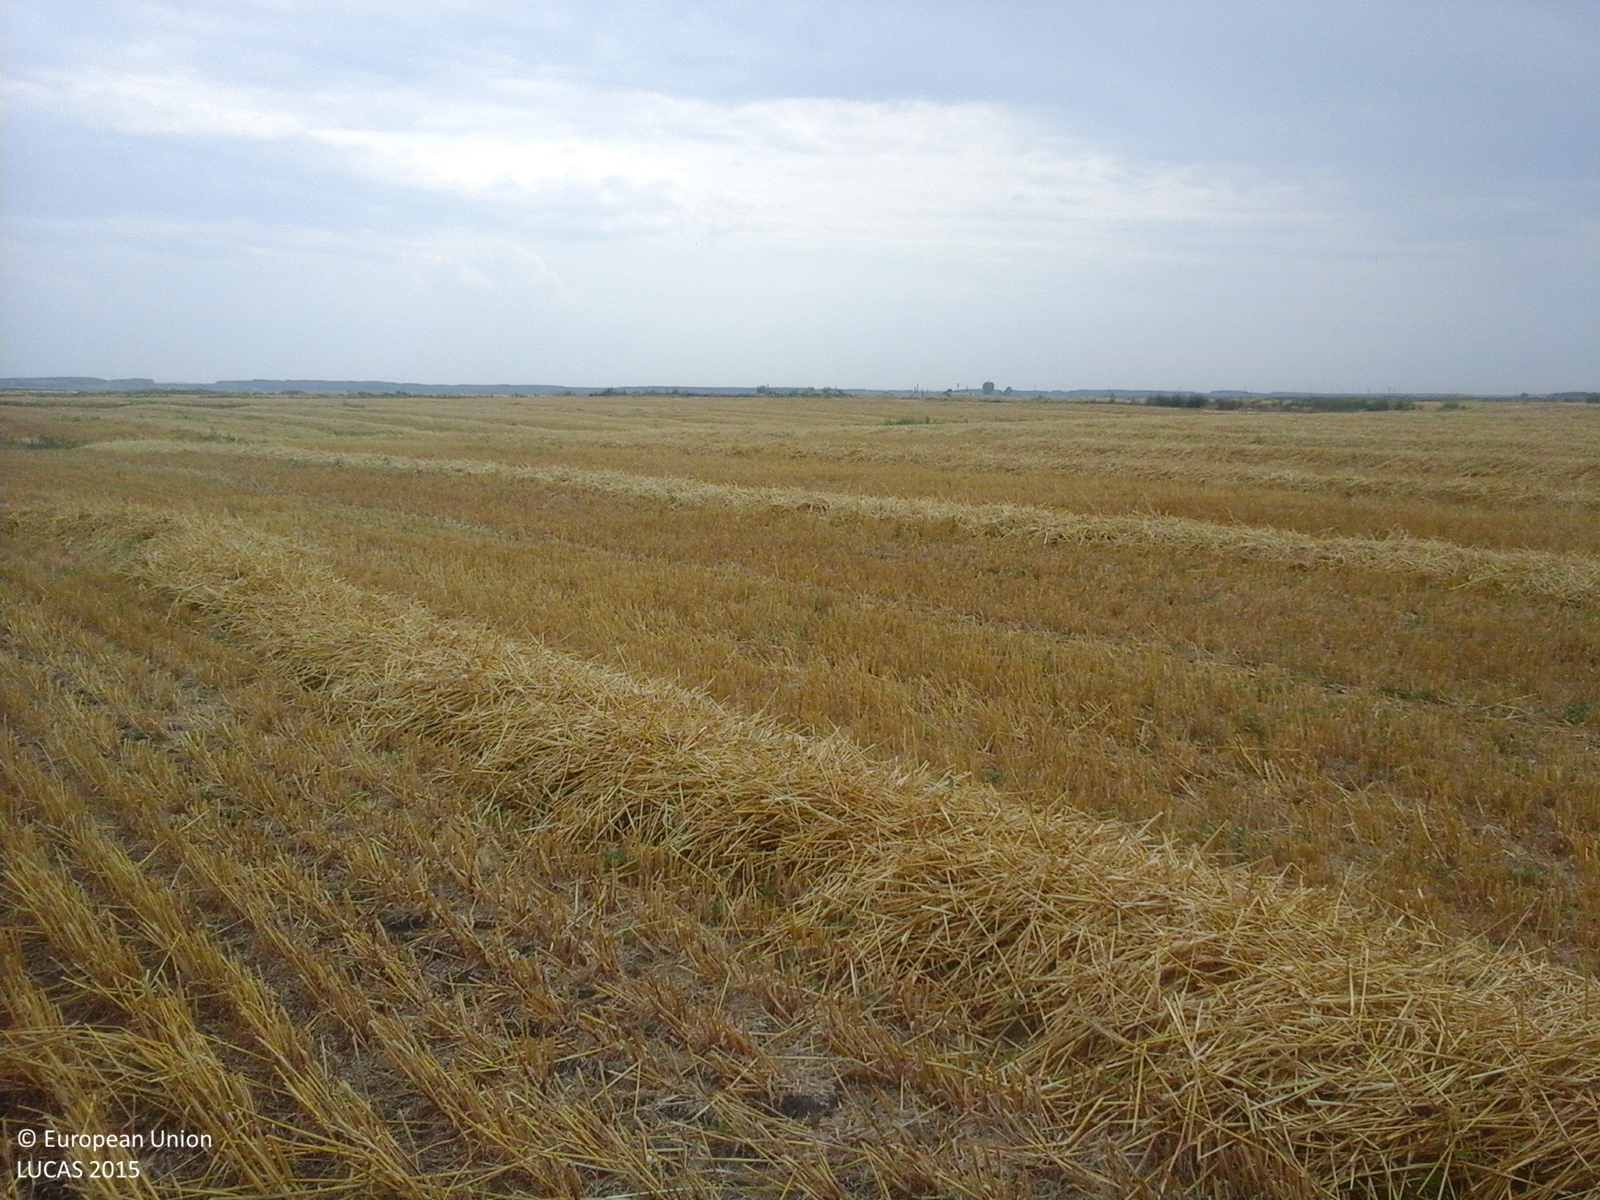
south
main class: Cropland
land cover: Barley
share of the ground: > 75 %
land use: Agriculture (excluding fallow land and kitchen gardens)
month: June
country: RO
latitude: 44.0659
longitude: 26.2731
